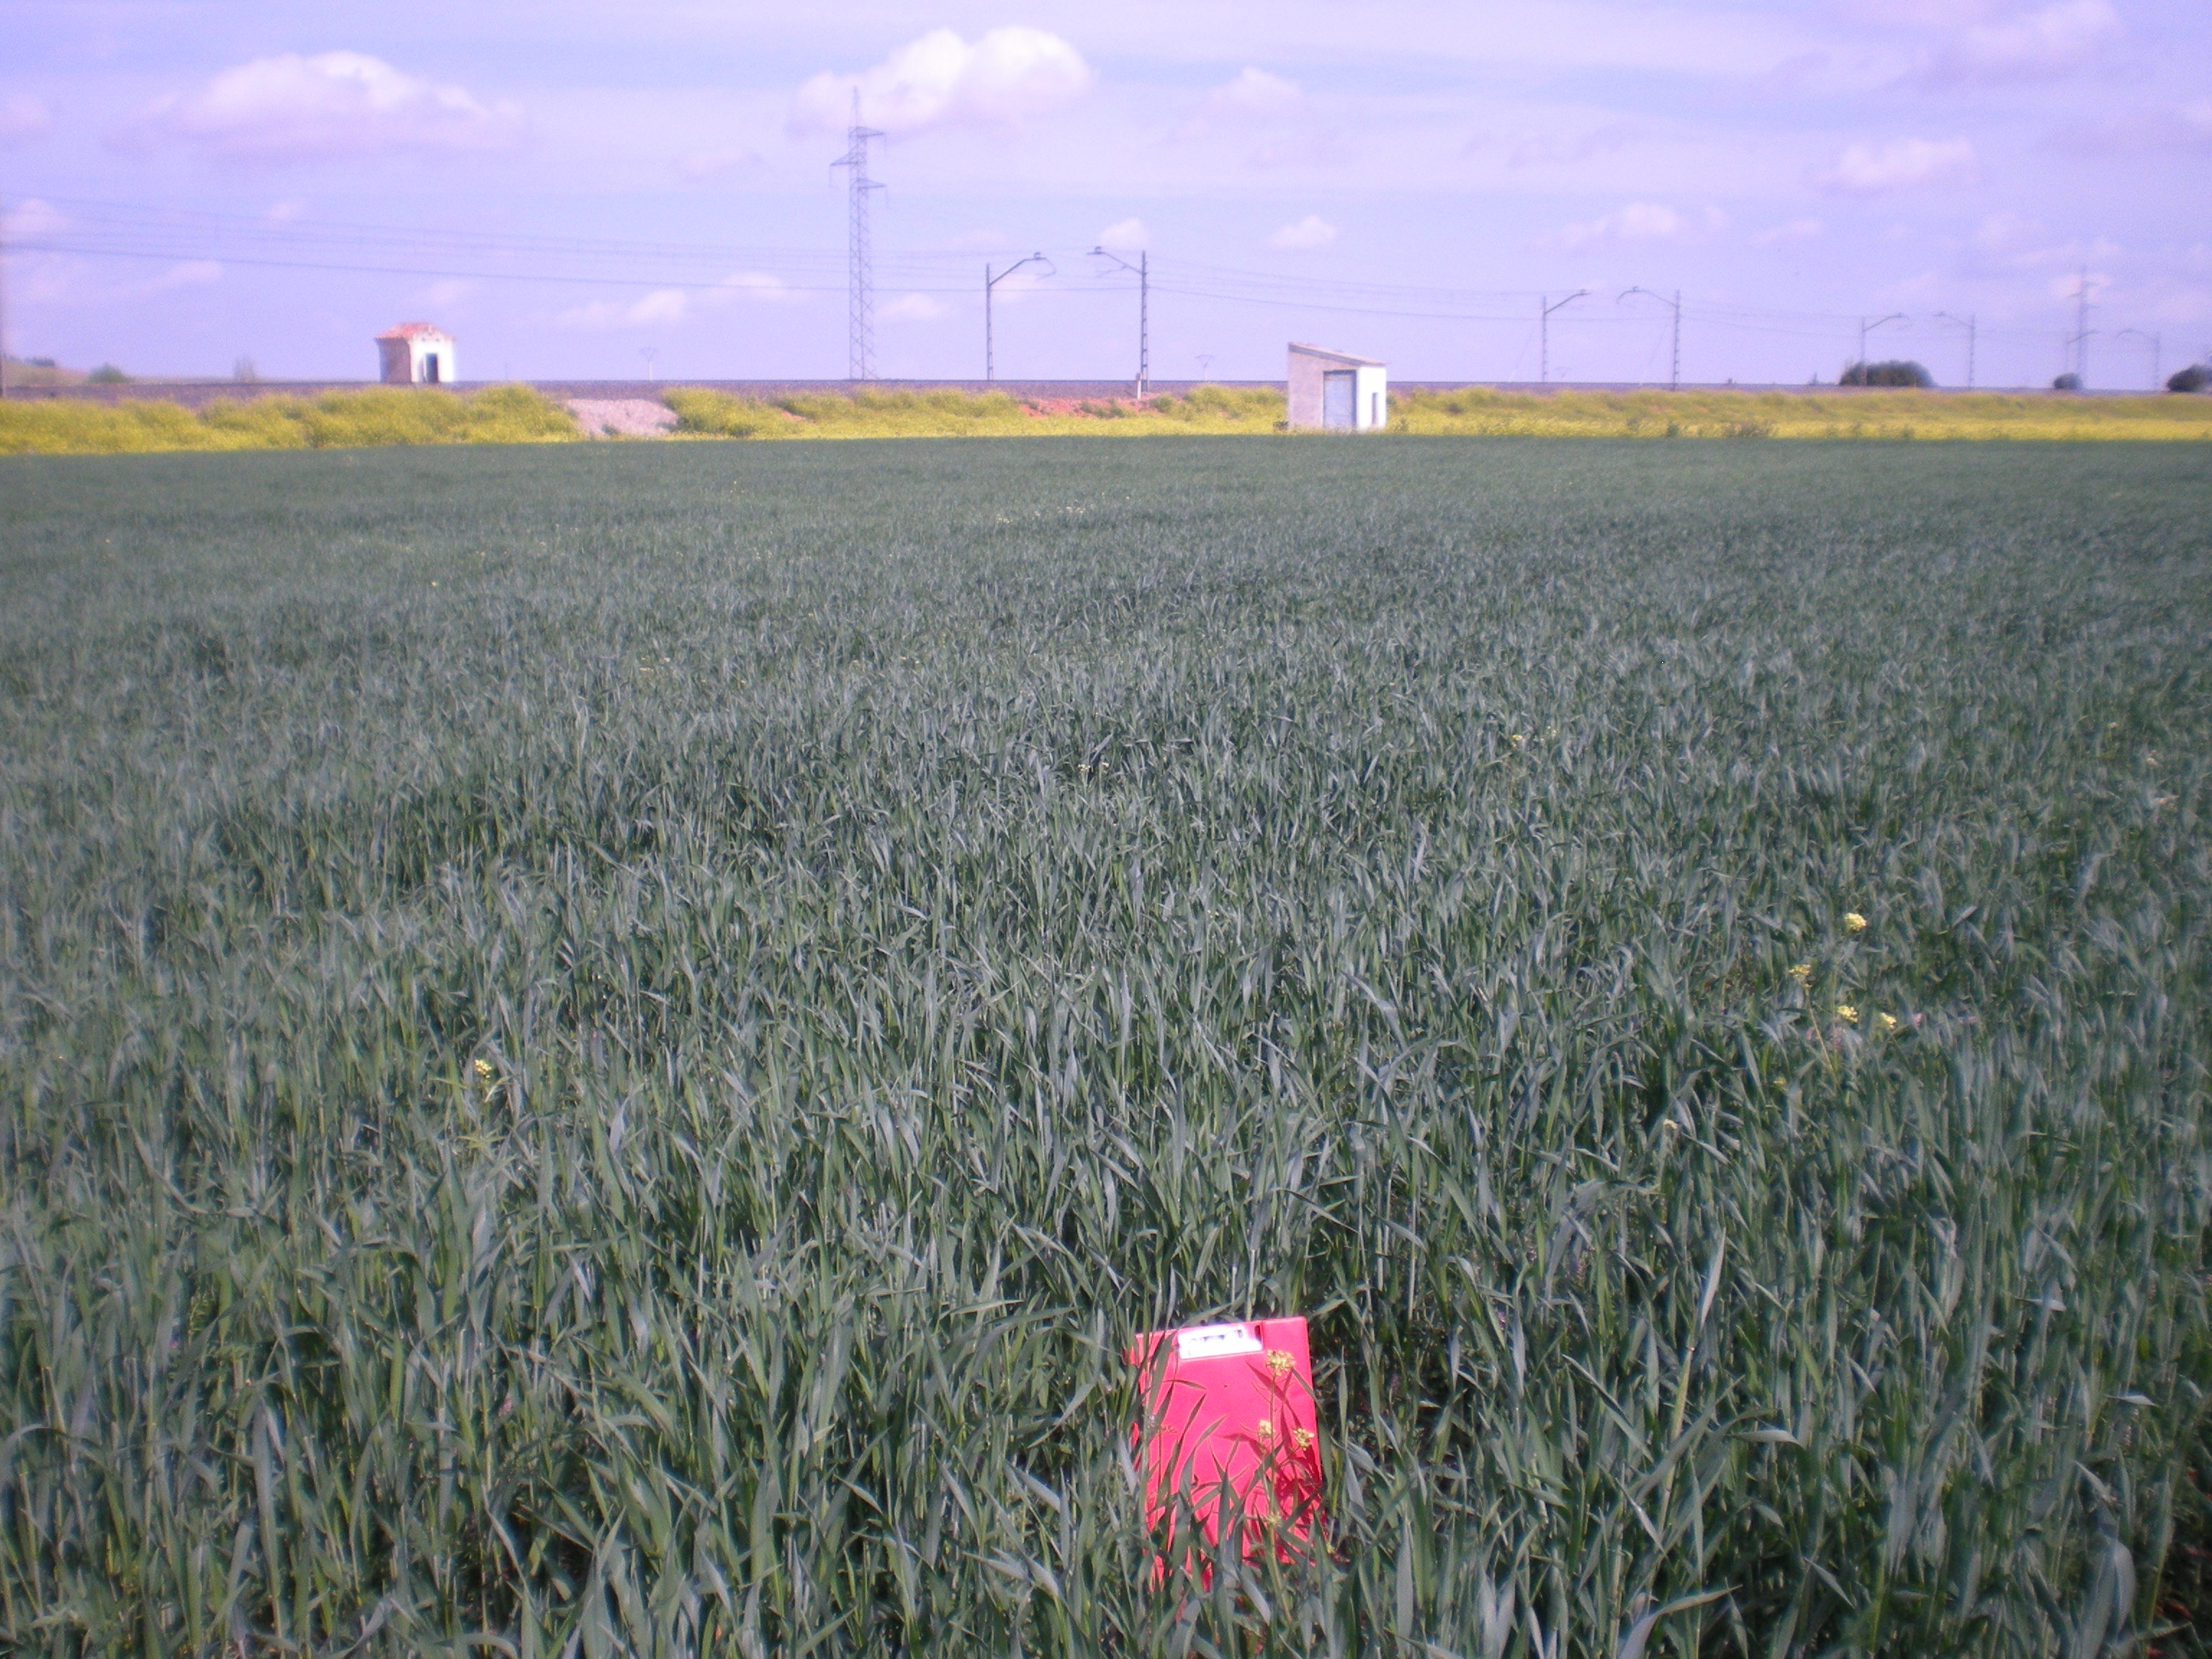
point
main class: Cropland
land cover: Durum wheat
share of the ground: > 75 %
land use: Agriculture (excluding fallow land and kitchen gardens)
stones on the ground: < 10 %
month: April
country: ES
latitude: 38.7192
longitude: -3.4097
